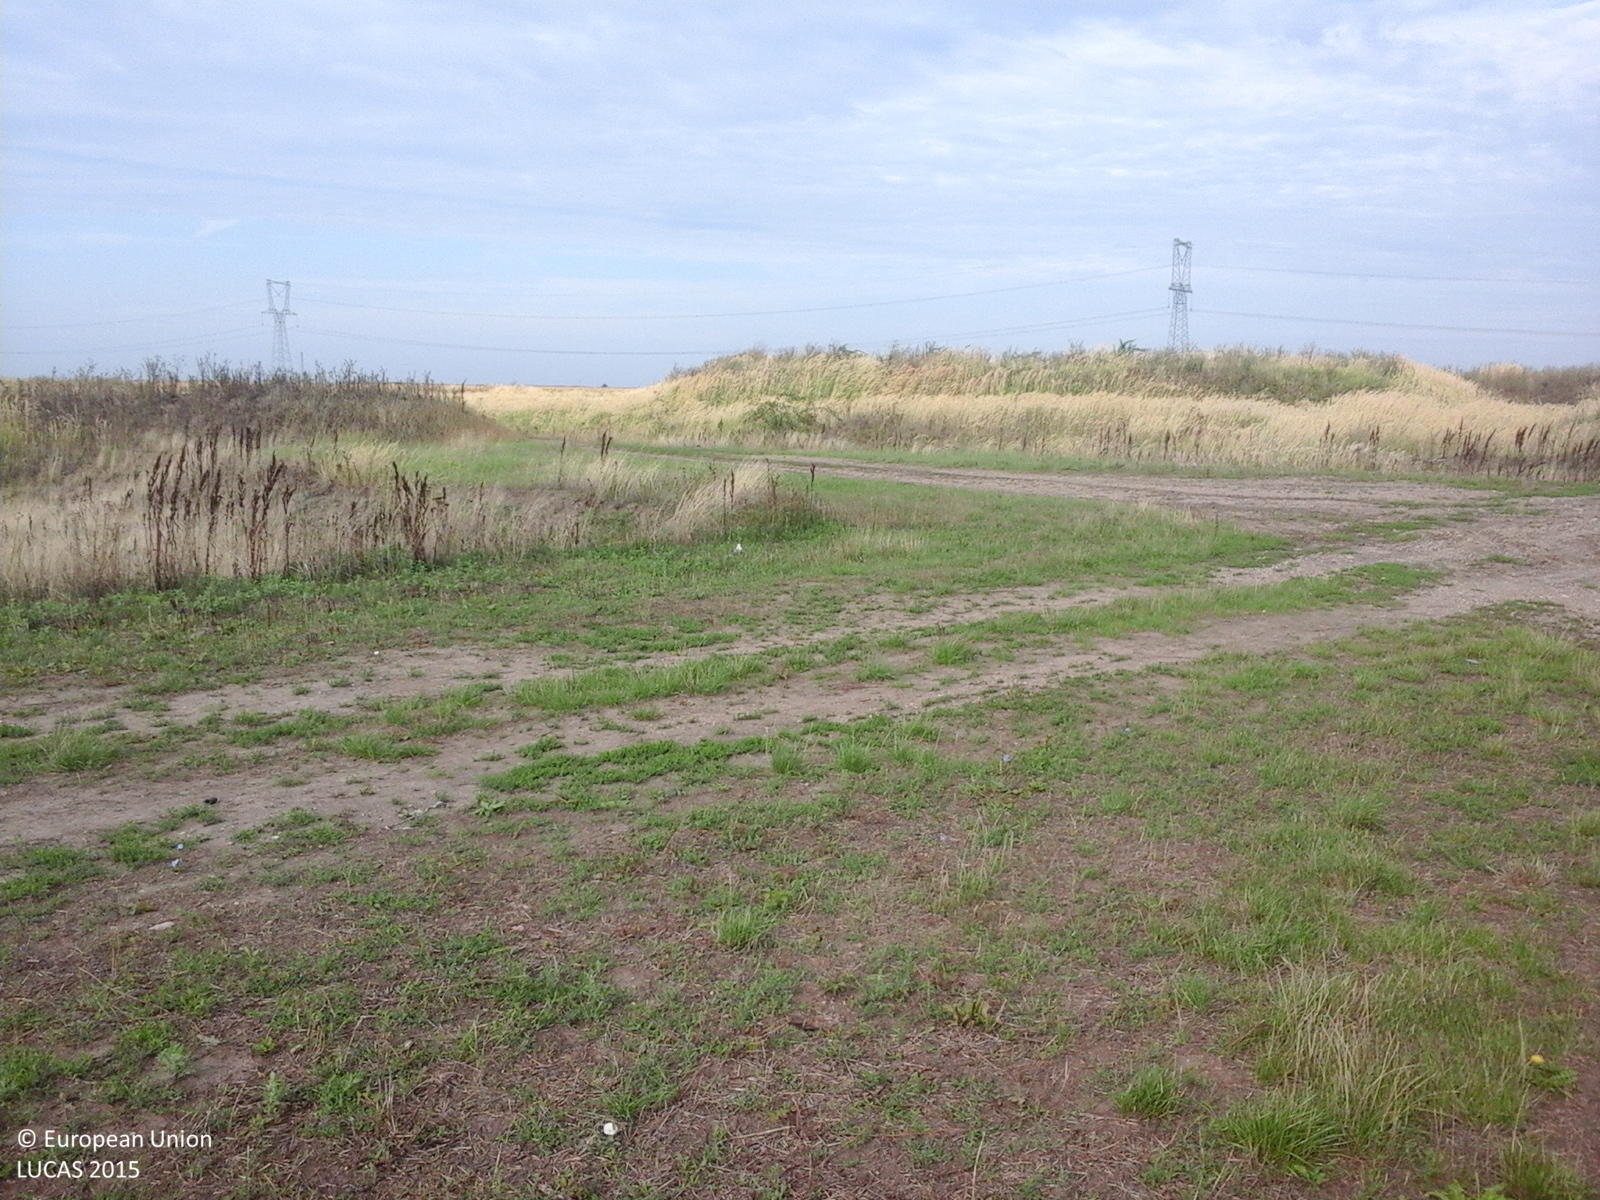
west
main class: Grassland
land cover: Grassland without tree/shrub cover
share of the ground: > 75 %
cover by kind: herbaceous plants 100 %
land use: Agriculture (excluding fallow land and kitchen gardens)
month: August
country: RO
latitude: 46.2626
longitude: 21.4399
